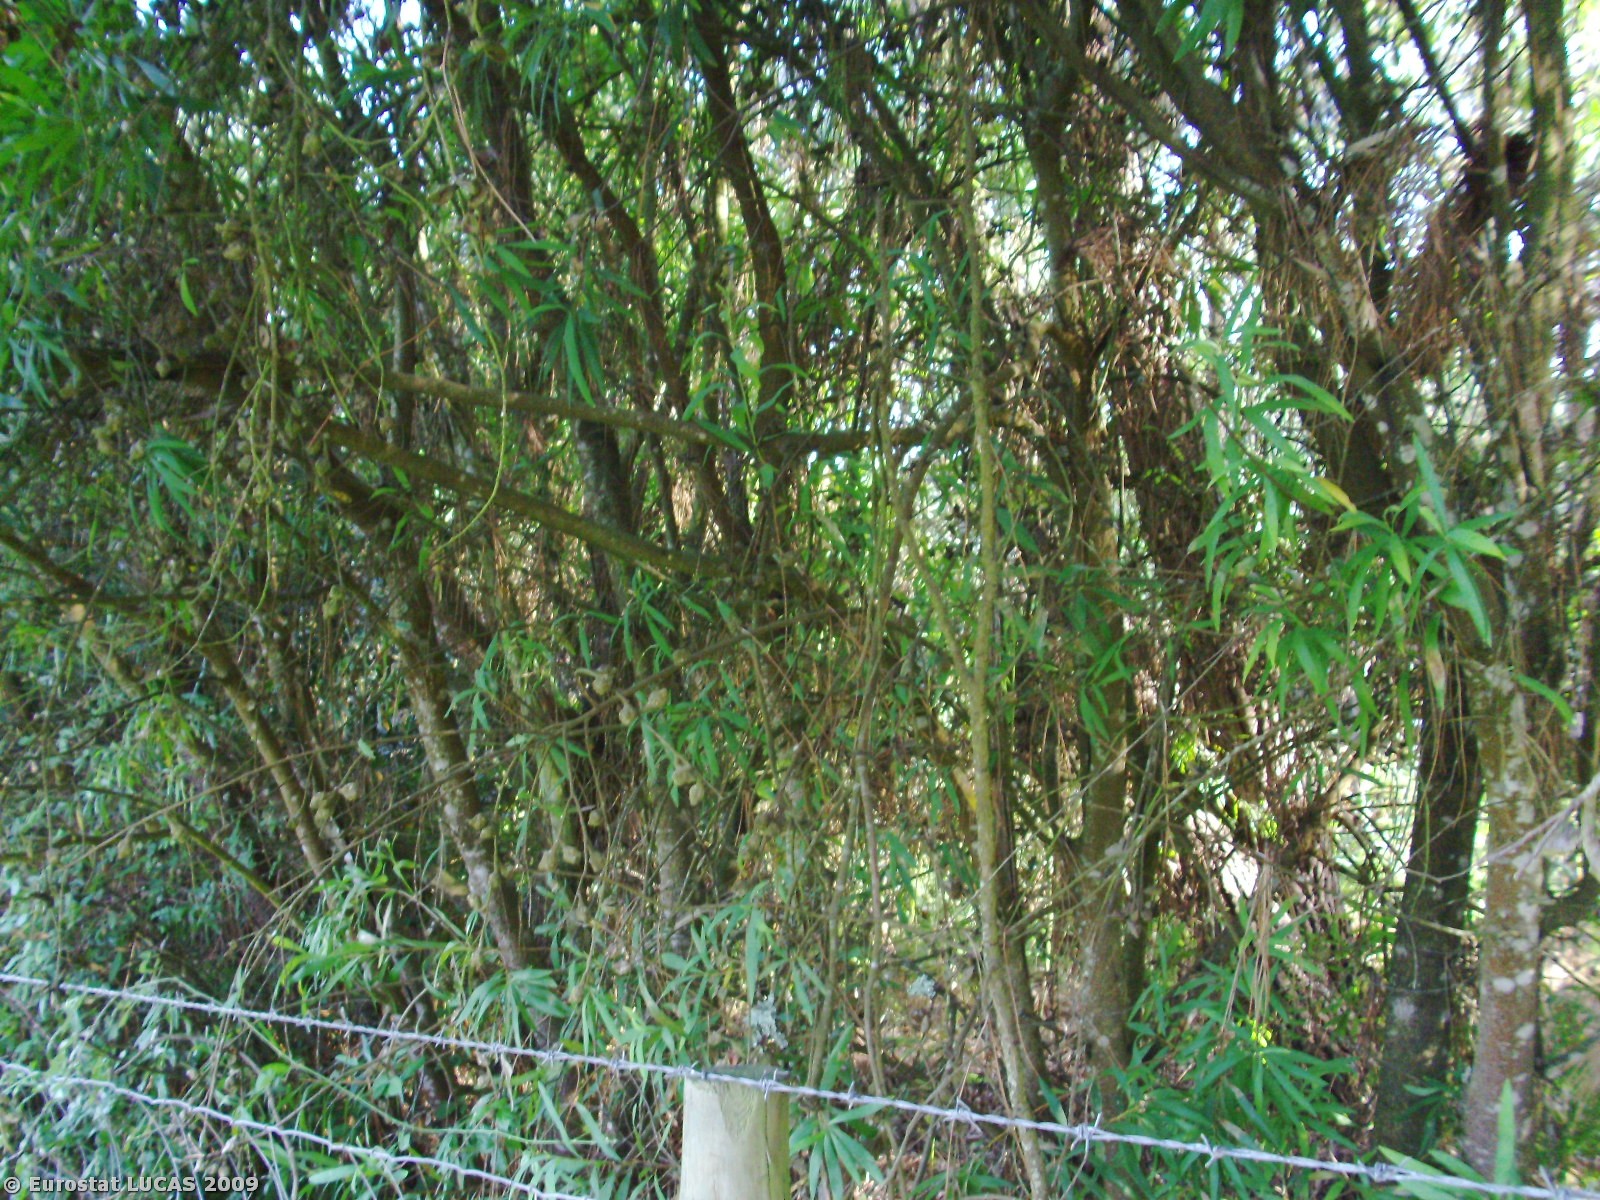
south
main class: Grassland
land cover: Grassland with sparse tree/shrub cover
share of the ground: > 75 %
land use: Agriculture (excluding fallow land and kitchen gardens)
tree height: > 5 m
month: June
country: PT
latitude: 37.3762
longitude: -8.7947
